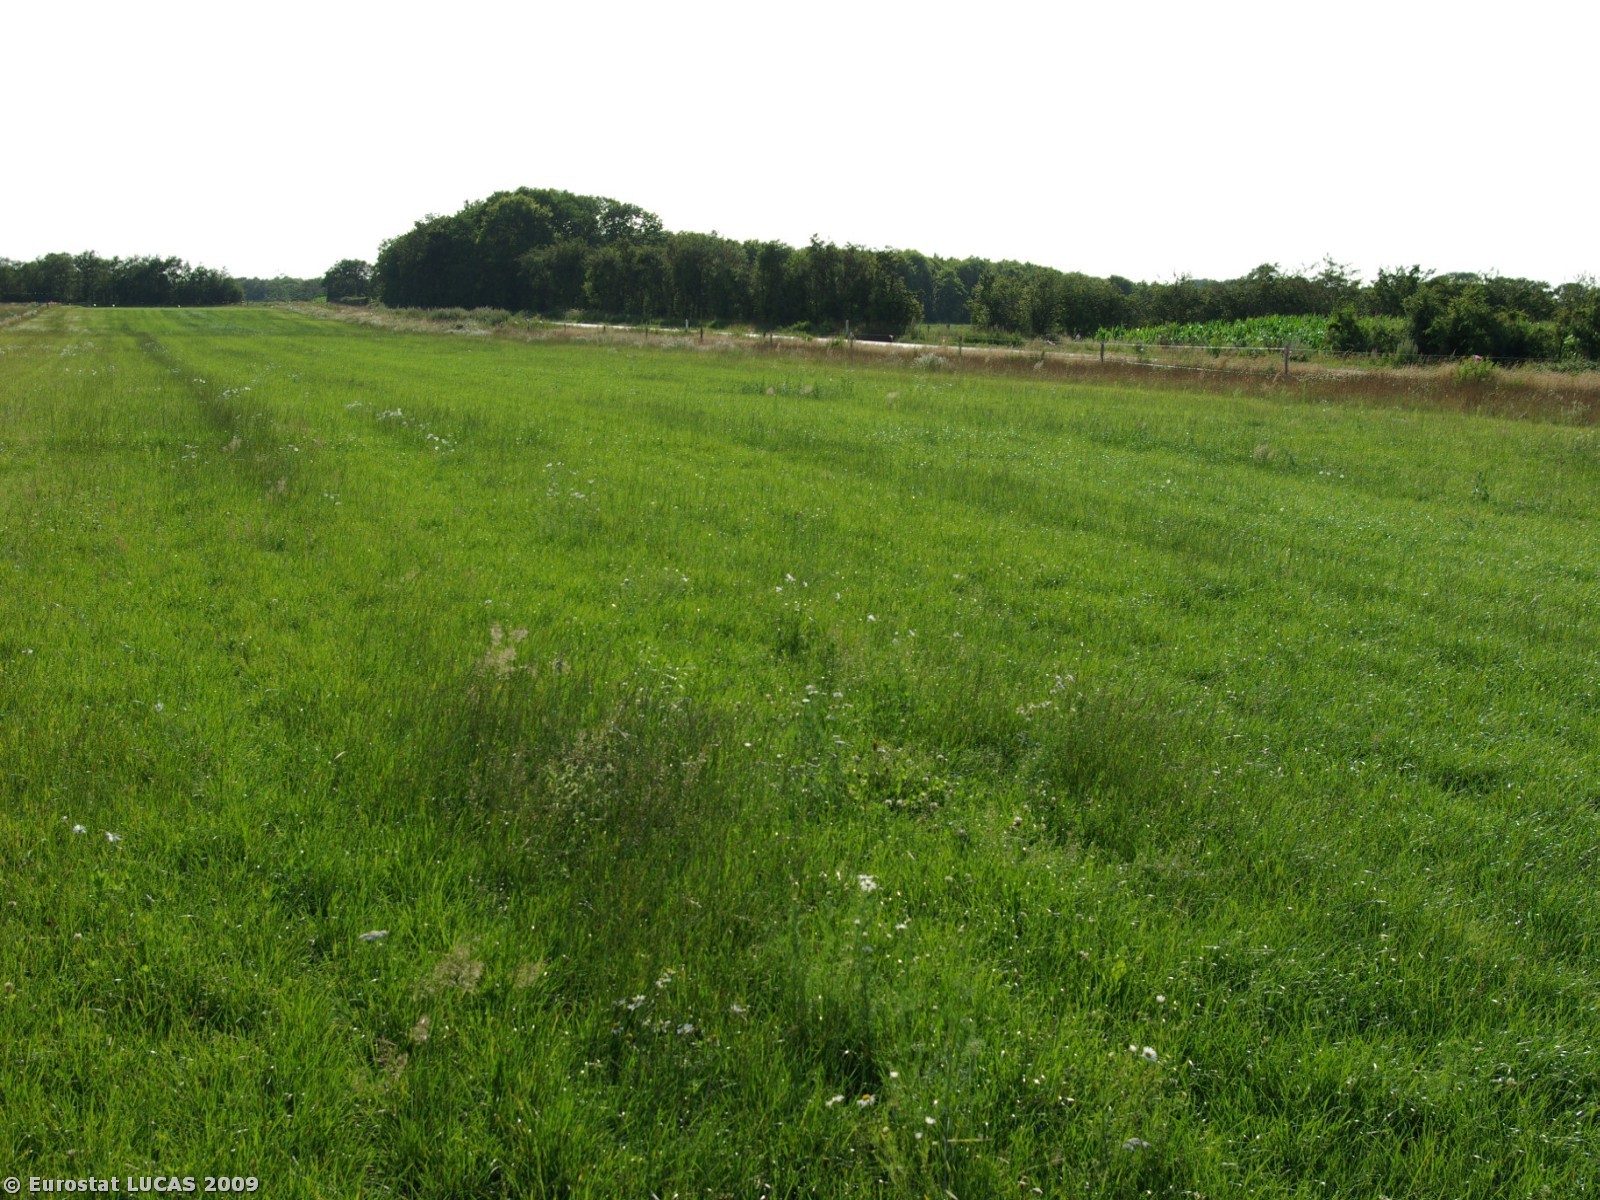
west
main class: Grassland
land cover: Grassland without tree/shrub cover
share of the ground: > 75 %
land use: Agriculture (excluding fallow land and kitchen gardens)
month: July
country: DK
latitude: 55.1763
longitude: 8.8861
